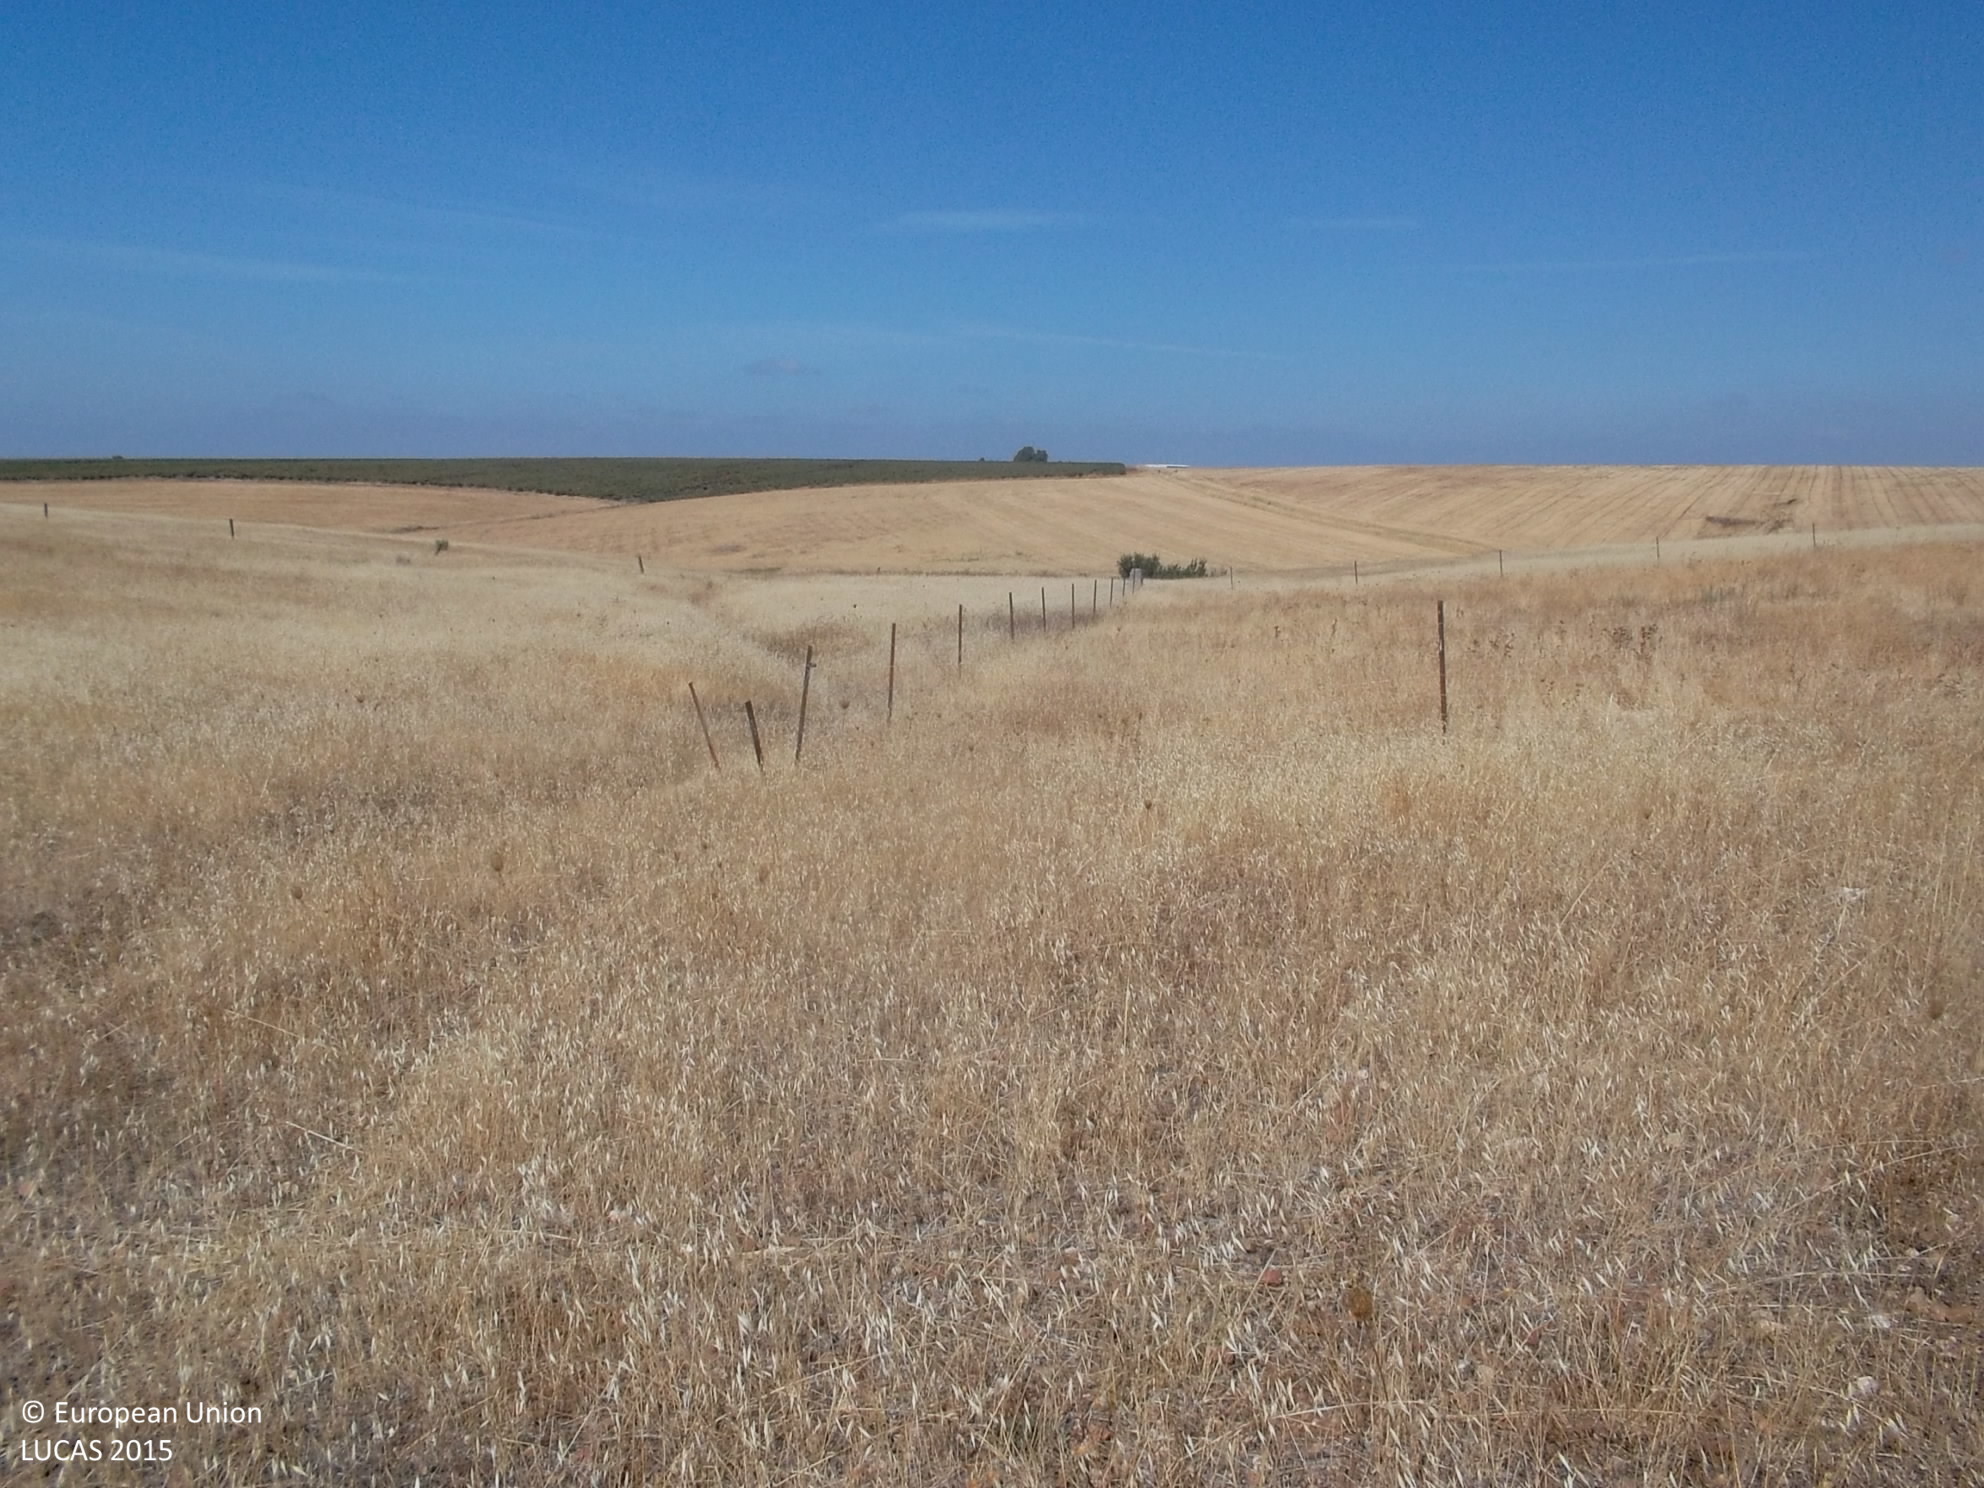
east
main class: Grassland
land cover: Spontaneously vegetated surfaces
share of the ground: > 75 %
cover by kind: herbaceous plants 100 %
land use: Agriculture (excluding fallow land and kitchen gardens)
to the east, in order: Spontaneously vegetated surfaces; Grass margins; Mixed cereals for fodder; Electric lines; Mixed cereals for fodder
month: September
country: ES
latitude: 38.3365
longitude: -6.3269
